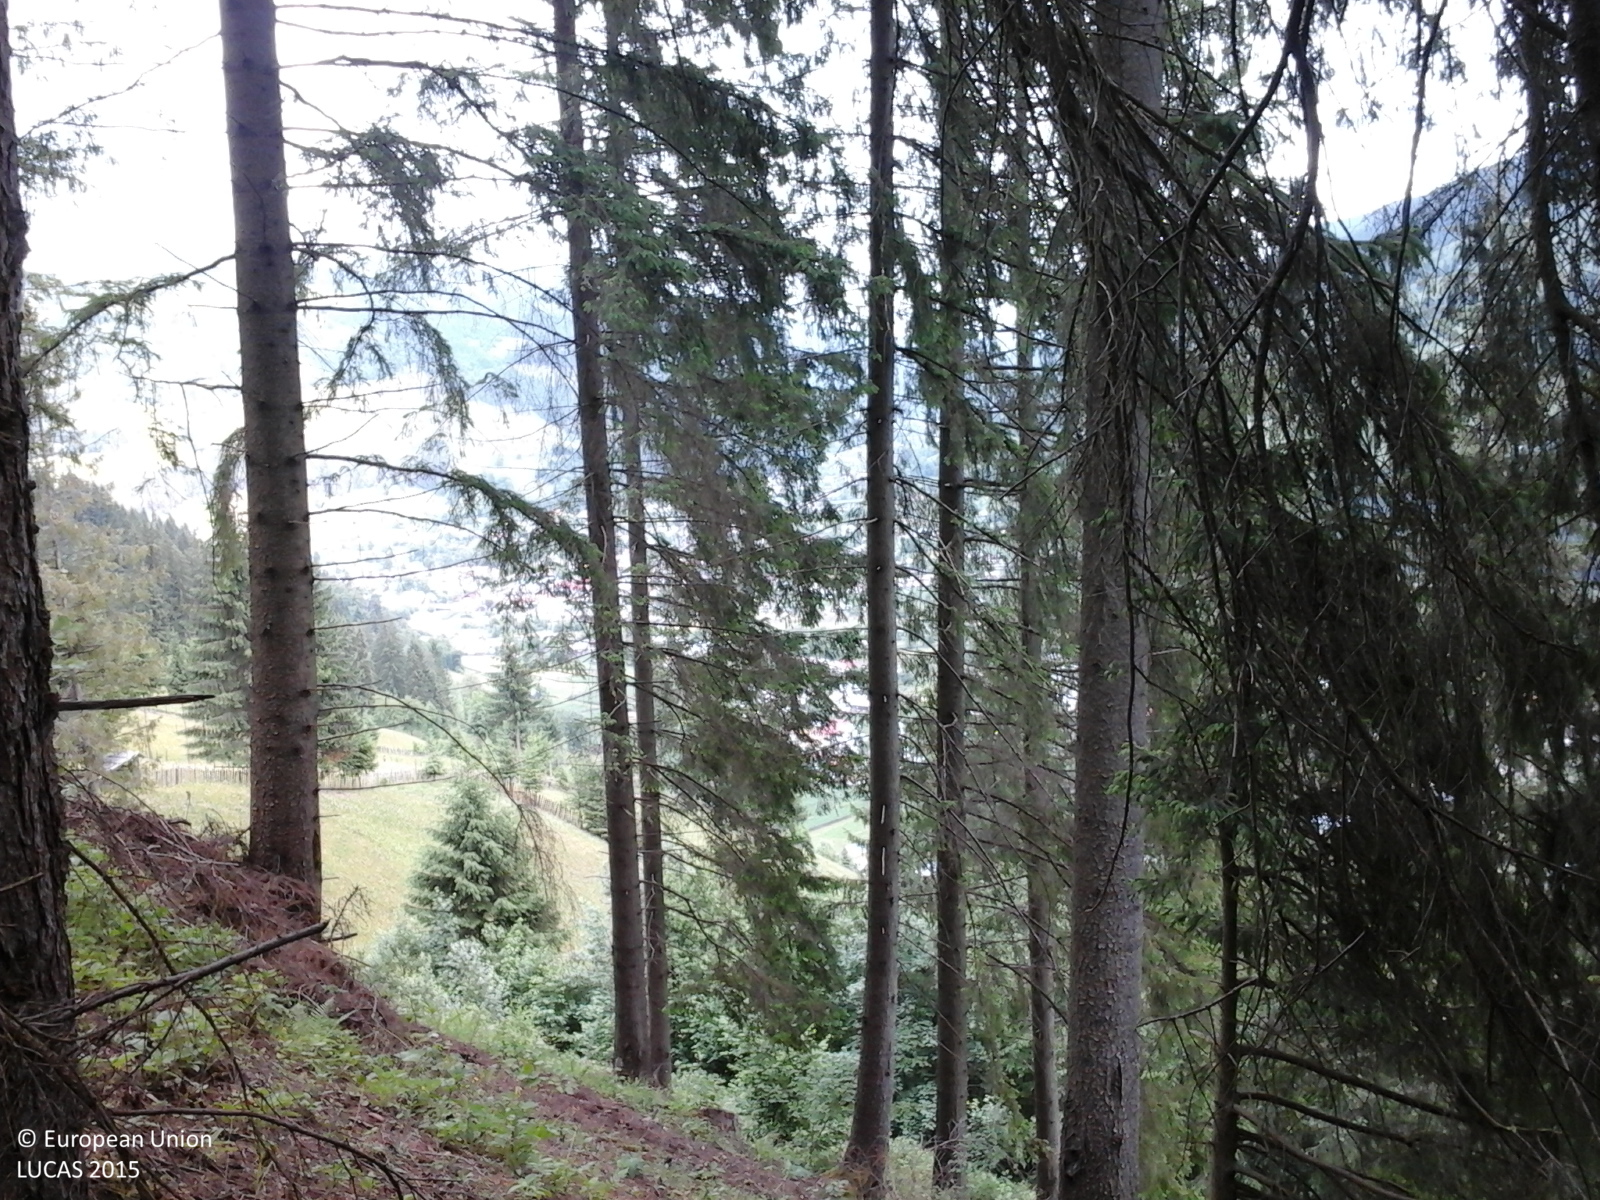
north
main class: Woodland
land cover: Spruce dominated coniferous woodland
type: alpine coniferous forest
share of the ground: > 75 %
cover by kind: coniferous forest trees 100 %
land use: Forestry
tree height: > 5 m
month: June
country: RO
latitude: 47.1692
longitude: 25.7804
